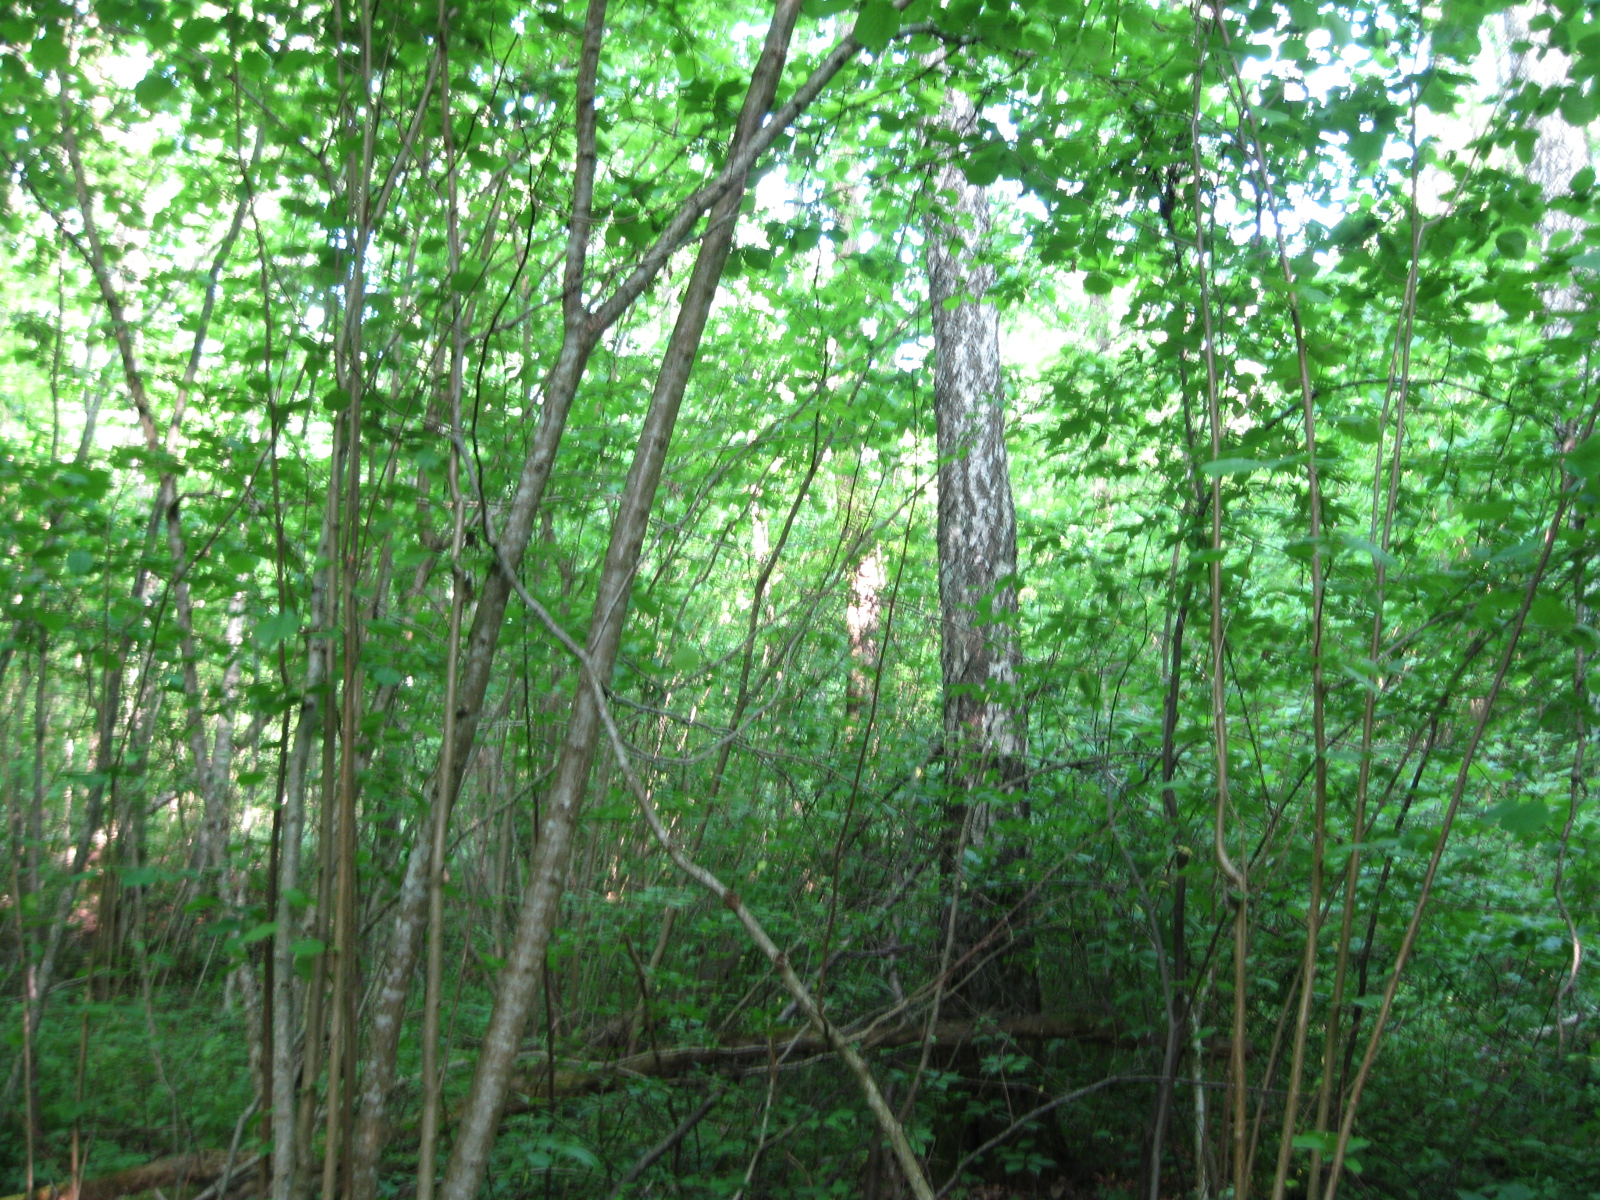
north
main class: Woodland
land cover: Broadleaved woodland
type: non-riverine alder, birch or aspen forest
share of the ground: > 75 %
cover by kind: broadleaved forest trees 90 %, shrubs 5 %, herbaceous plants 5 %
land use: Forestry
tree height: > 5 m
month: June
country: LT
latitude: 55.7904
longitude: 24.0765
